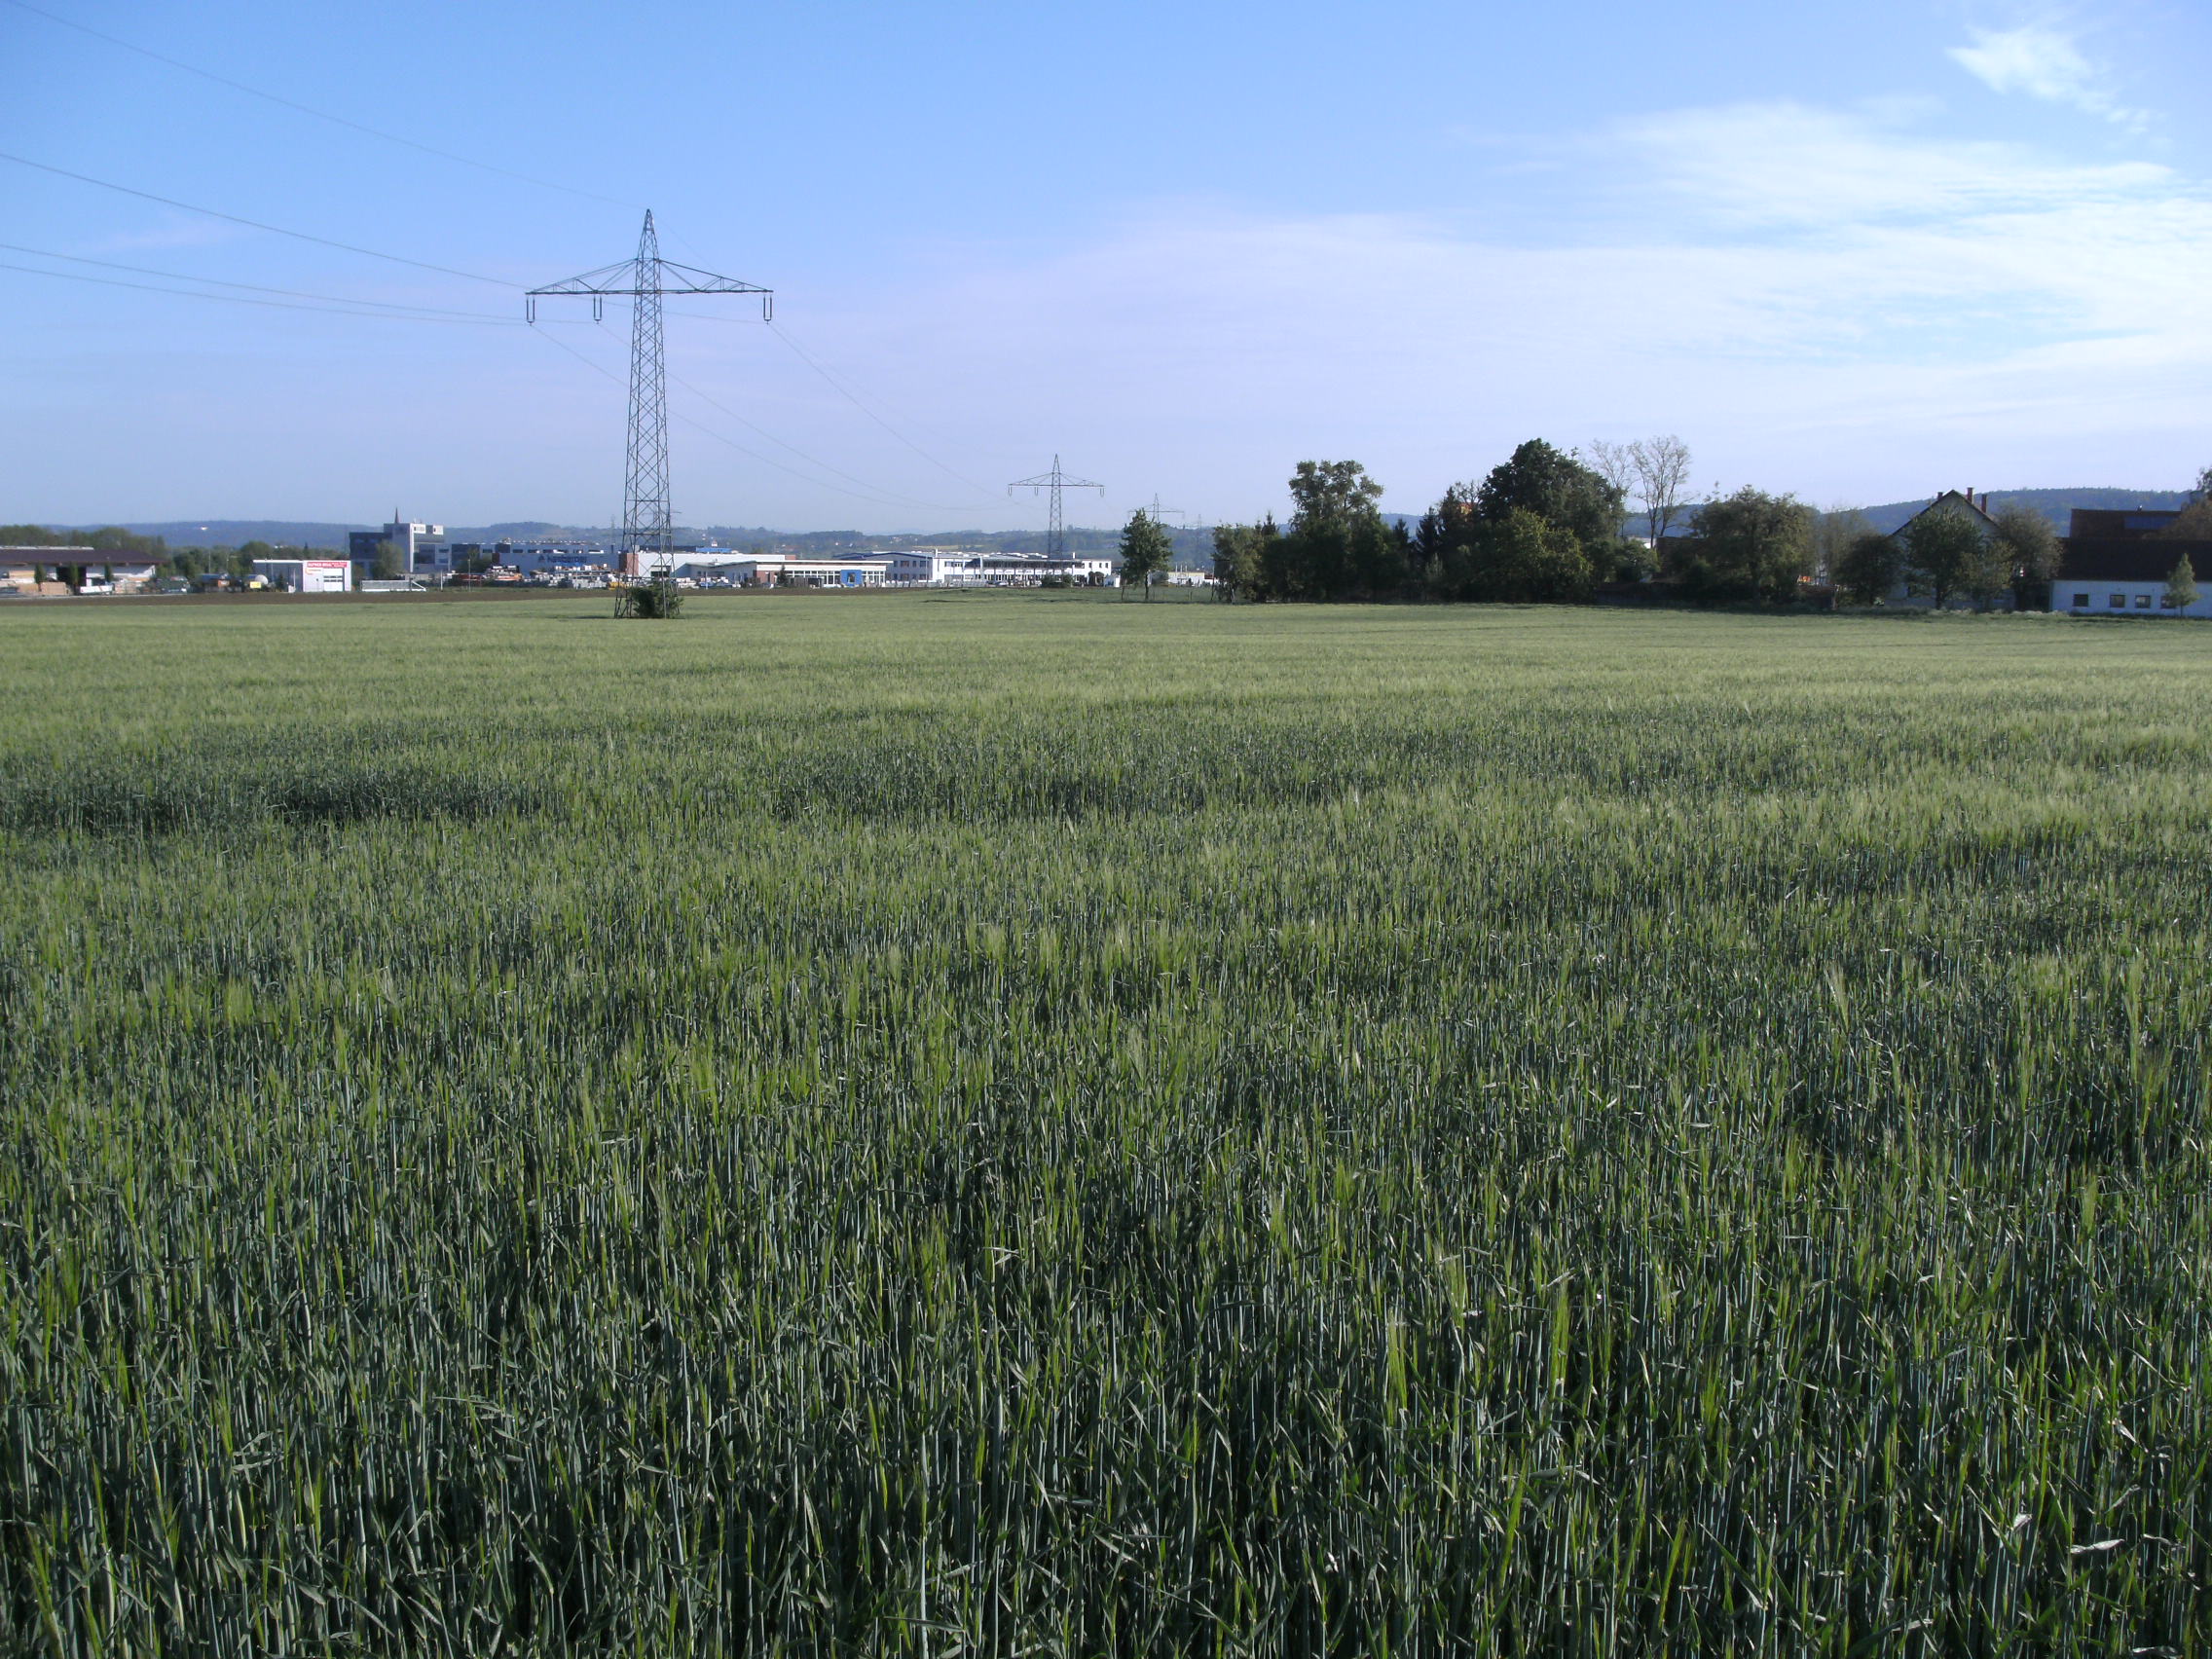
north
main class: Cropland
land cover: Barley
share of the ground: > 75 %
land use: Agriculture (excluding fallow land and kitchen gardens)
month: May
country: AT
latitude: 48.4219
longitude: 13.4452
